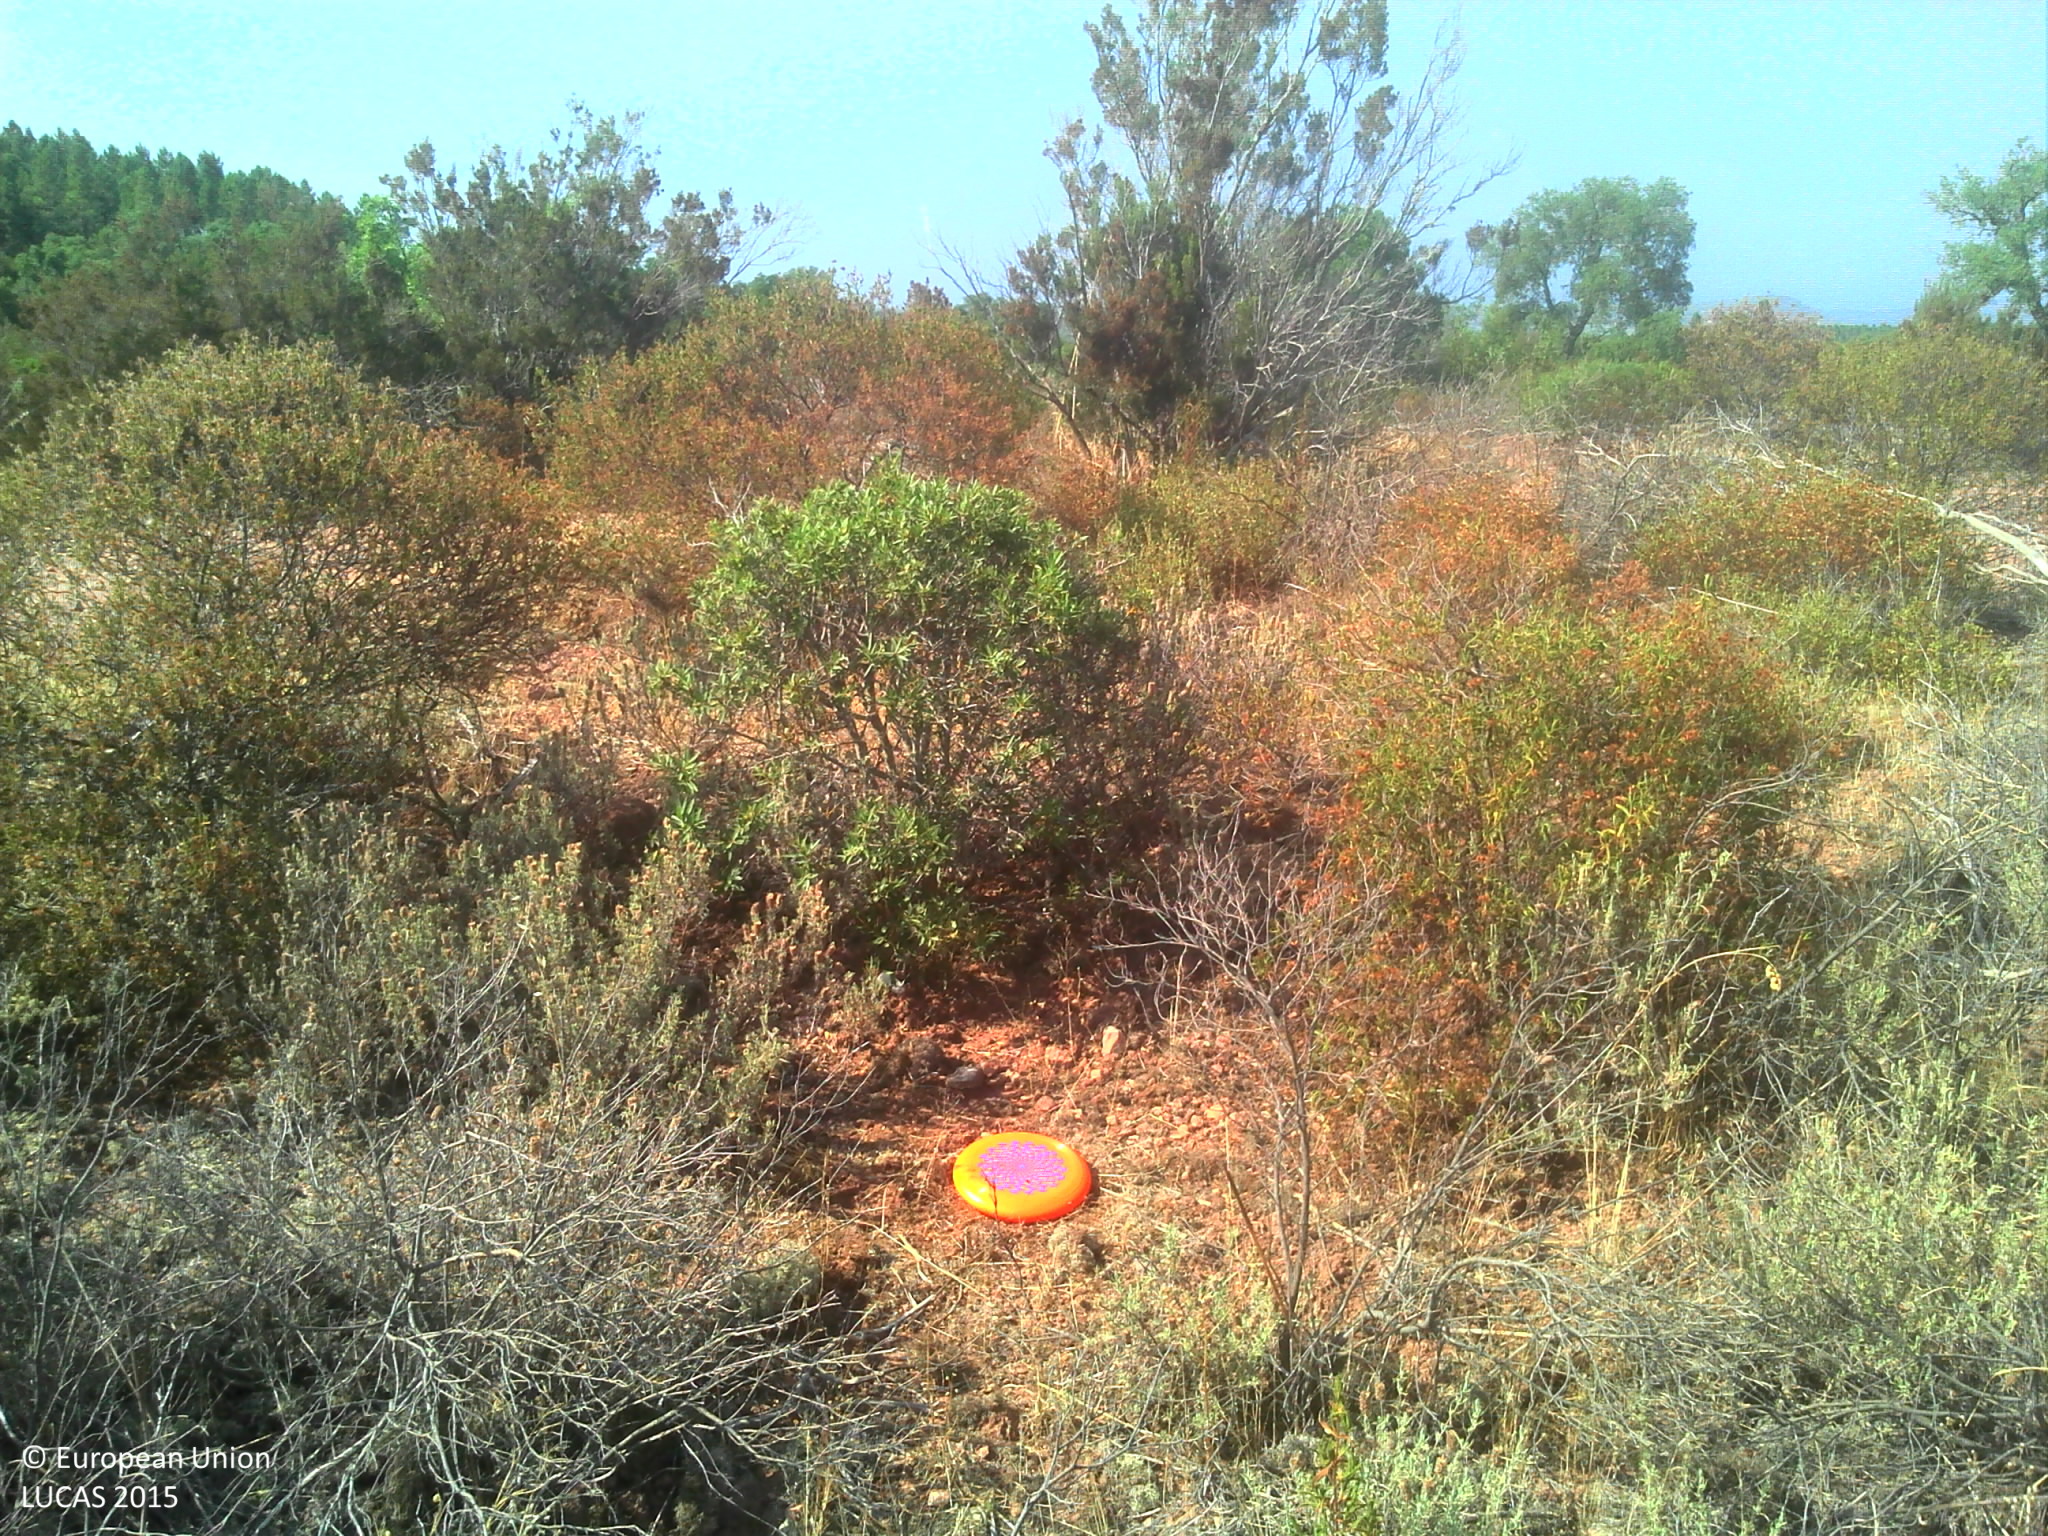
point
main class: Shrubland
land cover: Shrubland without tree cover
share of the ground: > 75 %
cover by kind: shrubs 100 %
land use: Semi-natural and natural areas not in use
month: July
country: FR
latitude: 43.3300
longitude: 6.3709
